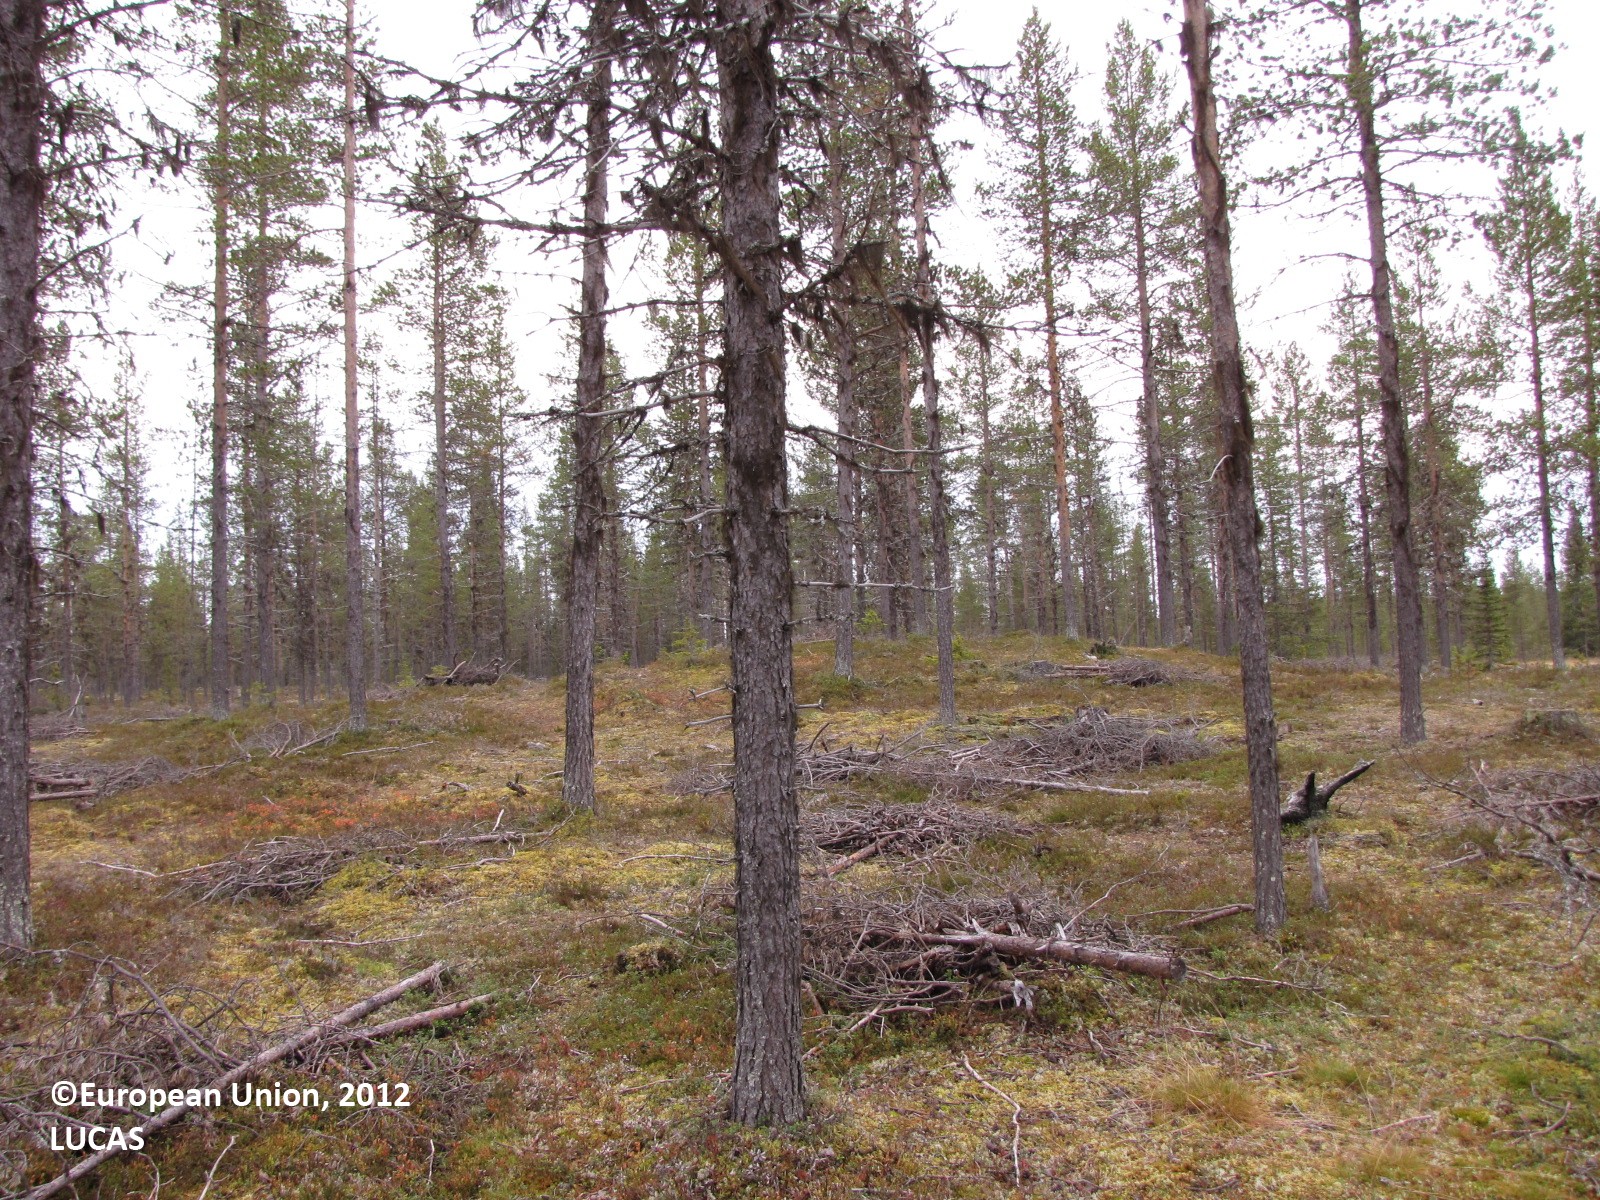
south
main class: Woodland
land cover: Pine dominated coniferous woodland
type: boreal forest
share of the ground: 25 - 50 %
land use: Forestry
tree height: > 5 m
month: September
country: FI
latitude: 67.7104
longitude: 24.1264
